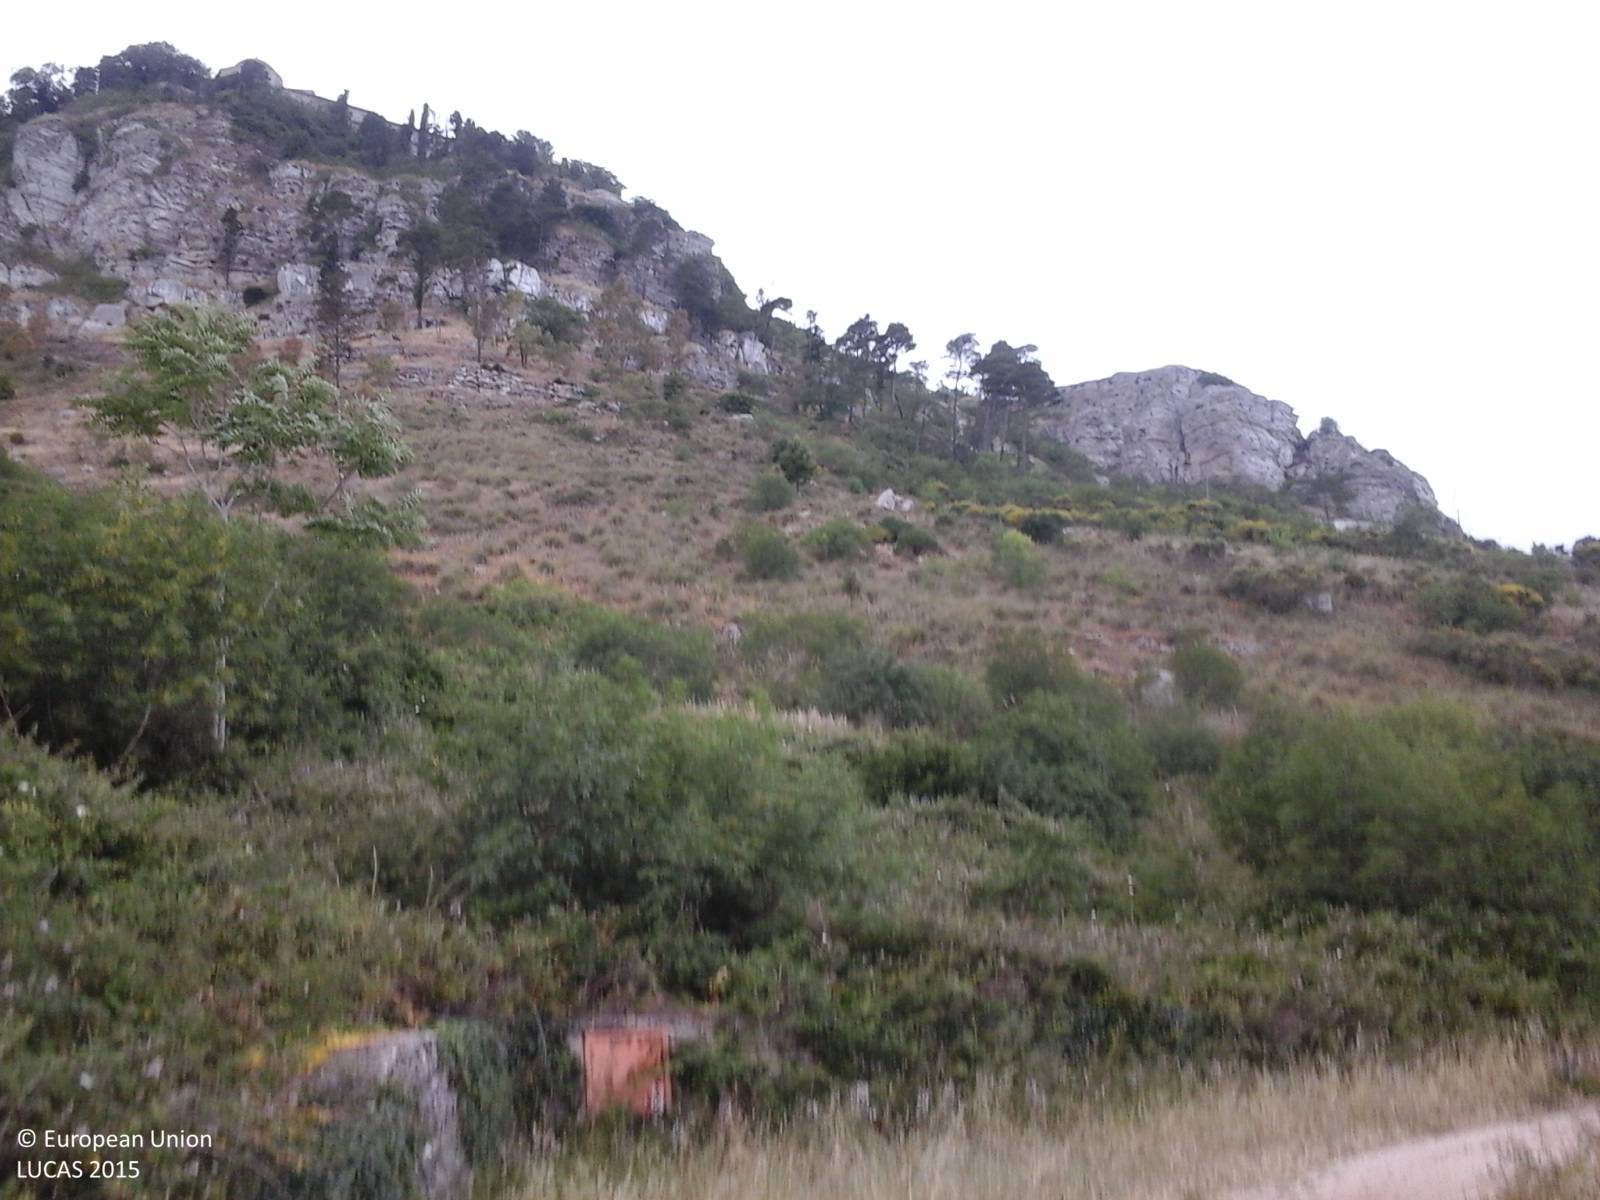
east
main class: Shrubland
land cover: Shrubland with sparse tree cover
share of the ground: > 75 %
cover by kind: herbaceous plants 85 %, shrubs 10 %, broadleaved forest trees 5 %
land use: Semi-natural and natural areas not in use
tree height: < 5 m
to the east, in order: Shrubland with sparse tree cover; Dry stone walls; Shrubland with sparse tree cover
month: June
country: IT
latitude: 38.0391
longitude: 12.5905
